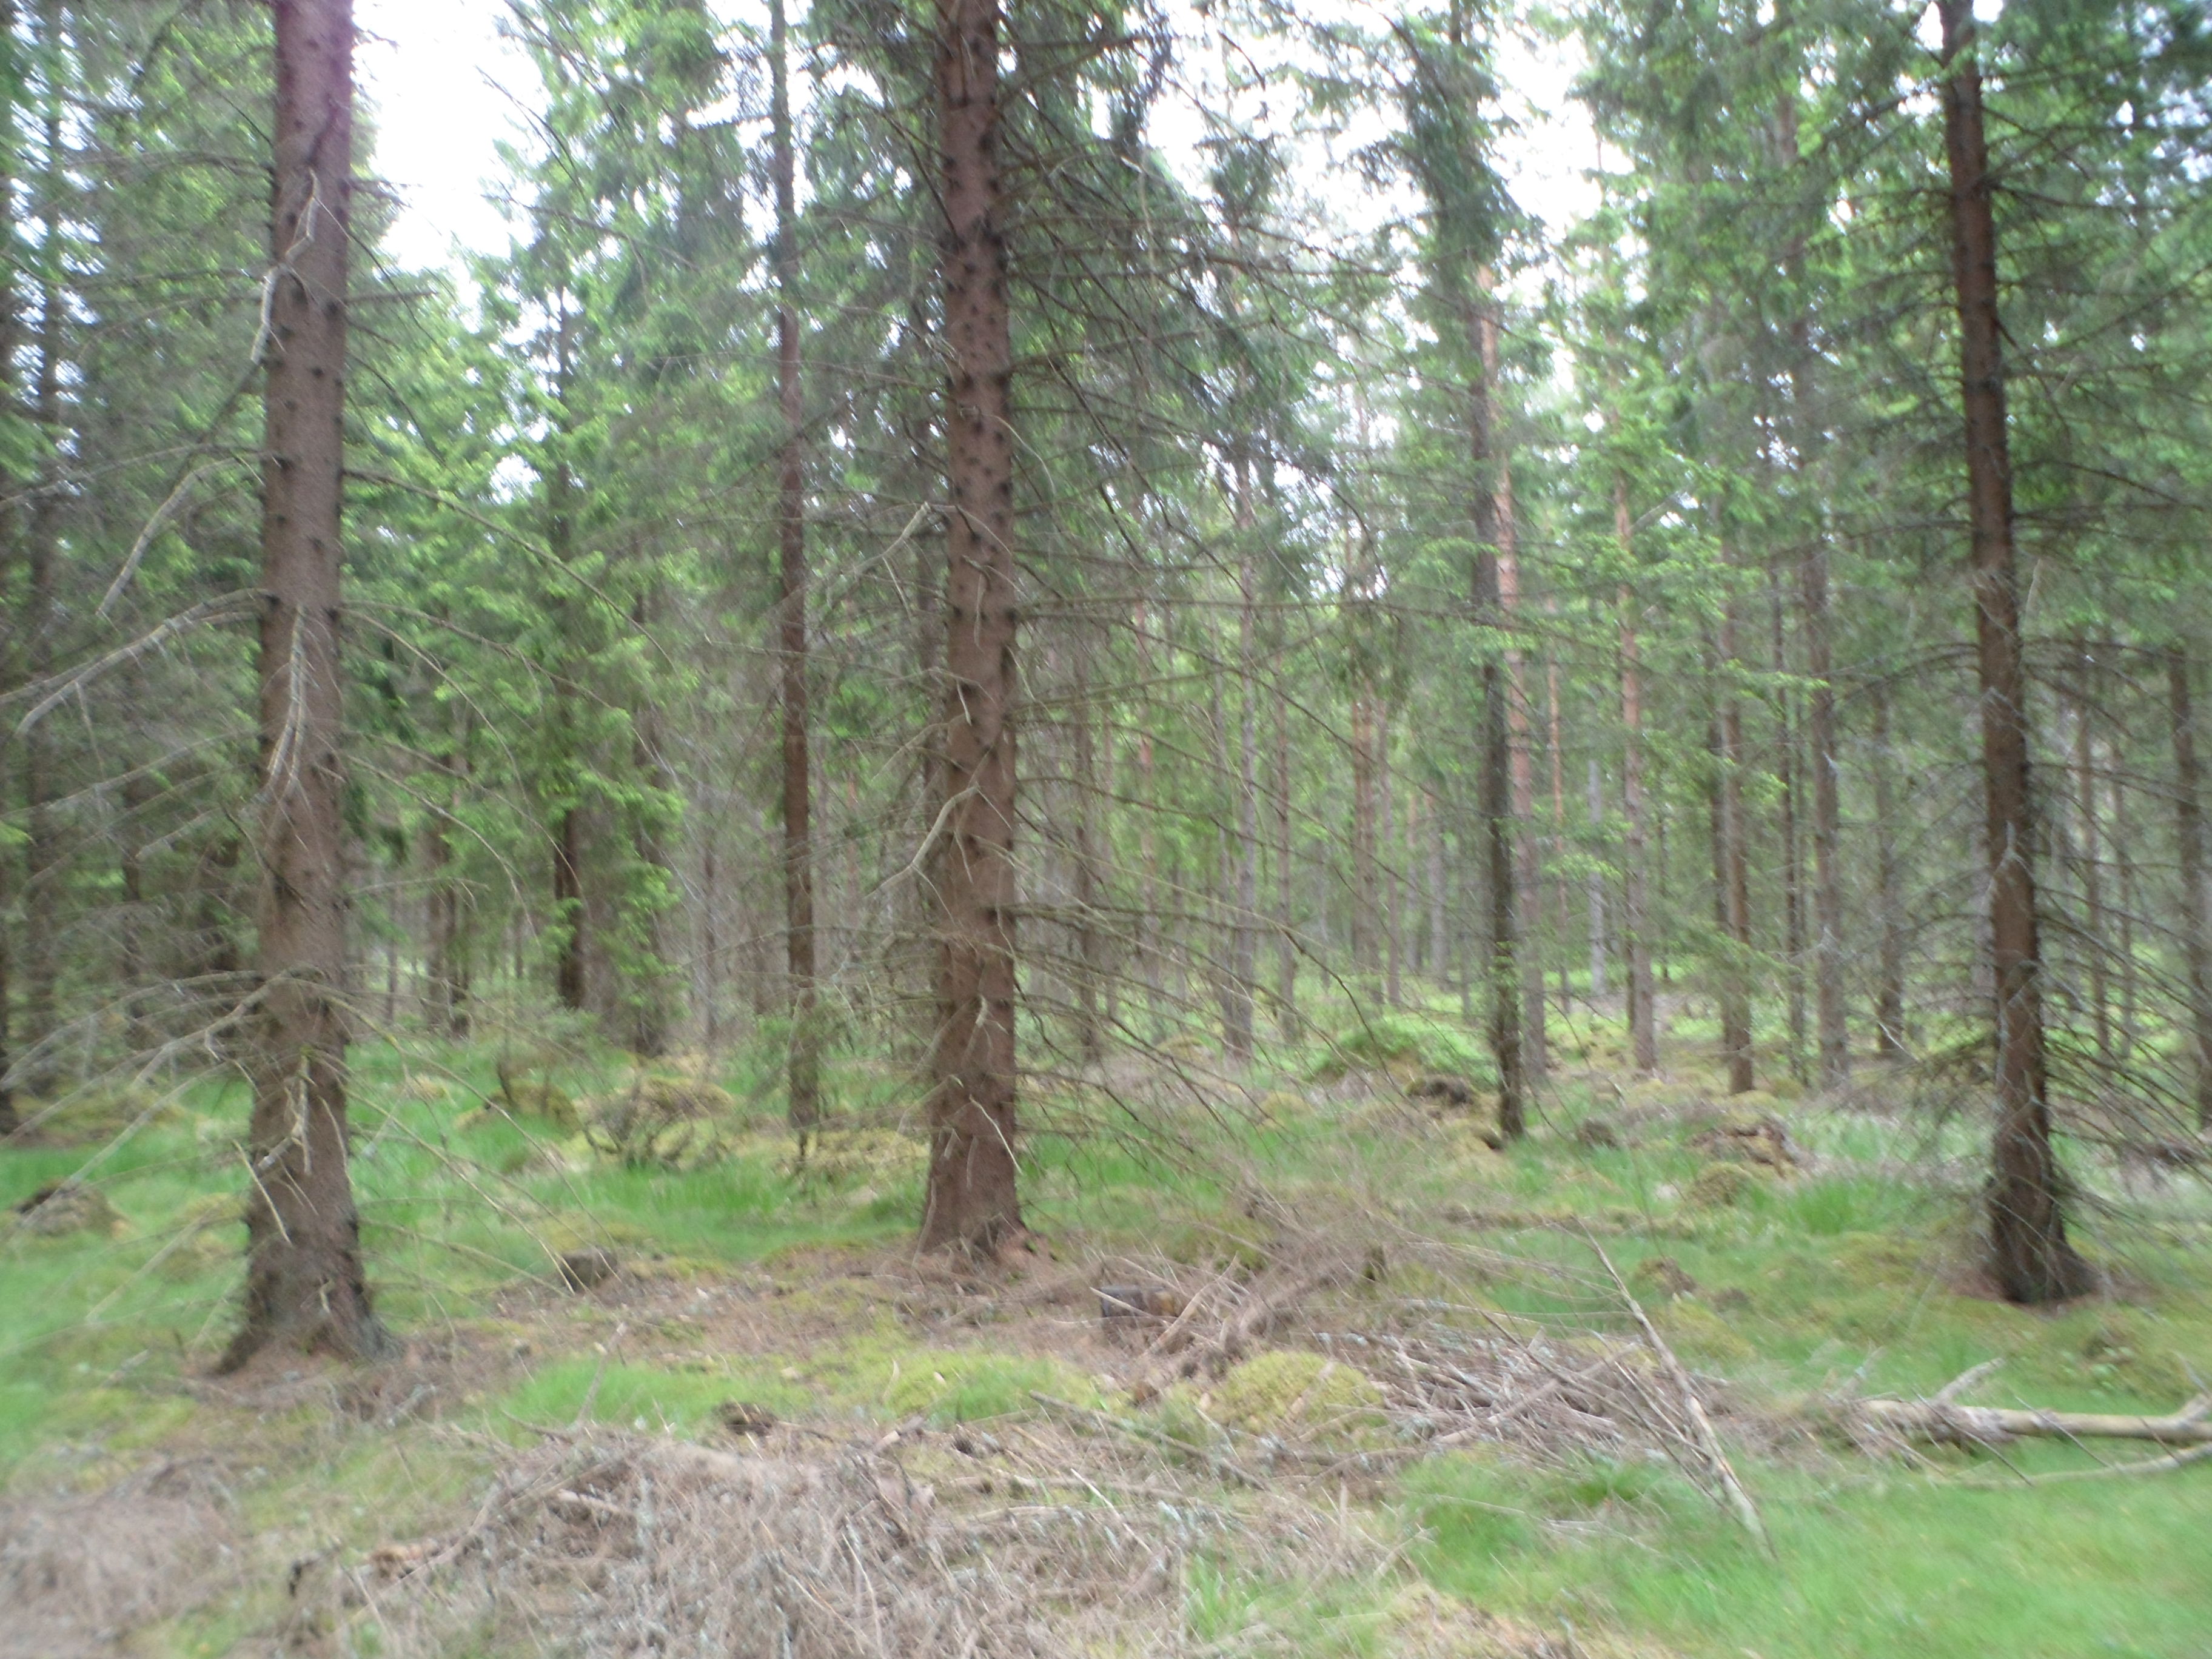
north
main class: Woodland
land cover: Spruce dominated coniferous woodland
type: boreal forest
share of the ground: 50 - 75 %
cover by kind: coniferous forest trees 60 %, lichens and mosses 25 %, herbaceous plants 15 %
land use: Forestry
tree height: > 5 m
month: June
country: SE
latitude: 56.8123
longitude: 14.4687
